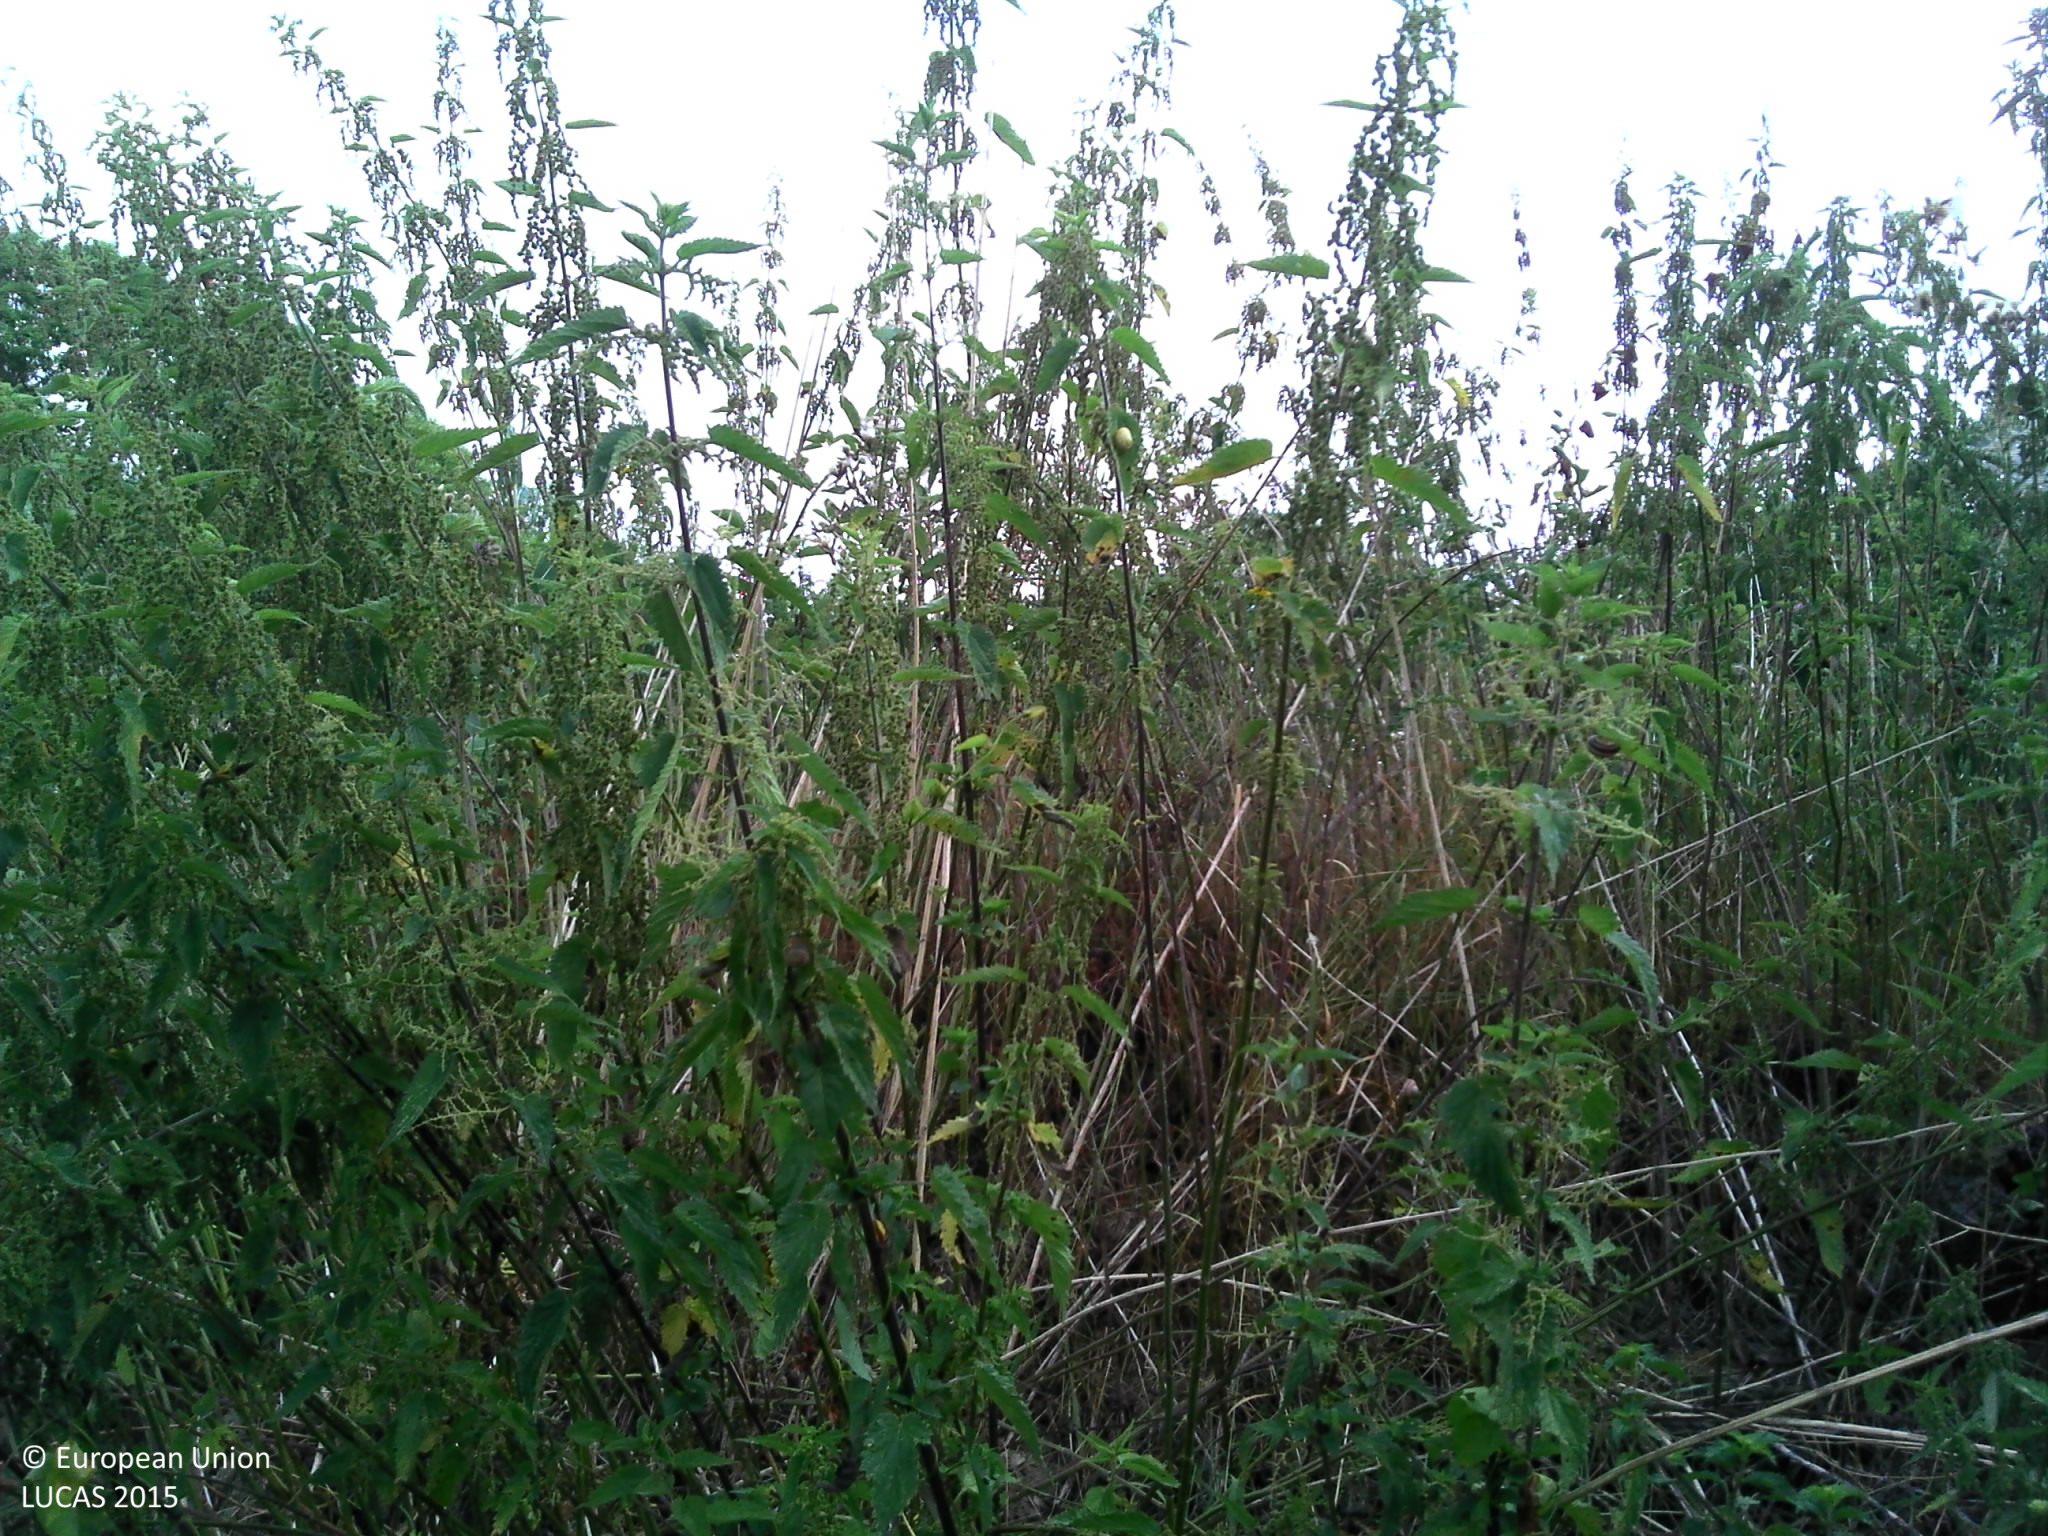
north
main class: Grassland
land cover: Spontaneously vegetated surfaces
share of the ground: > 75 %
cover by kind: herbaceous plants 95 %
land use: Semi-natural and natural areas not in use
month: July
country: FR
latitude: 45.6690
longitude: 1.0692
